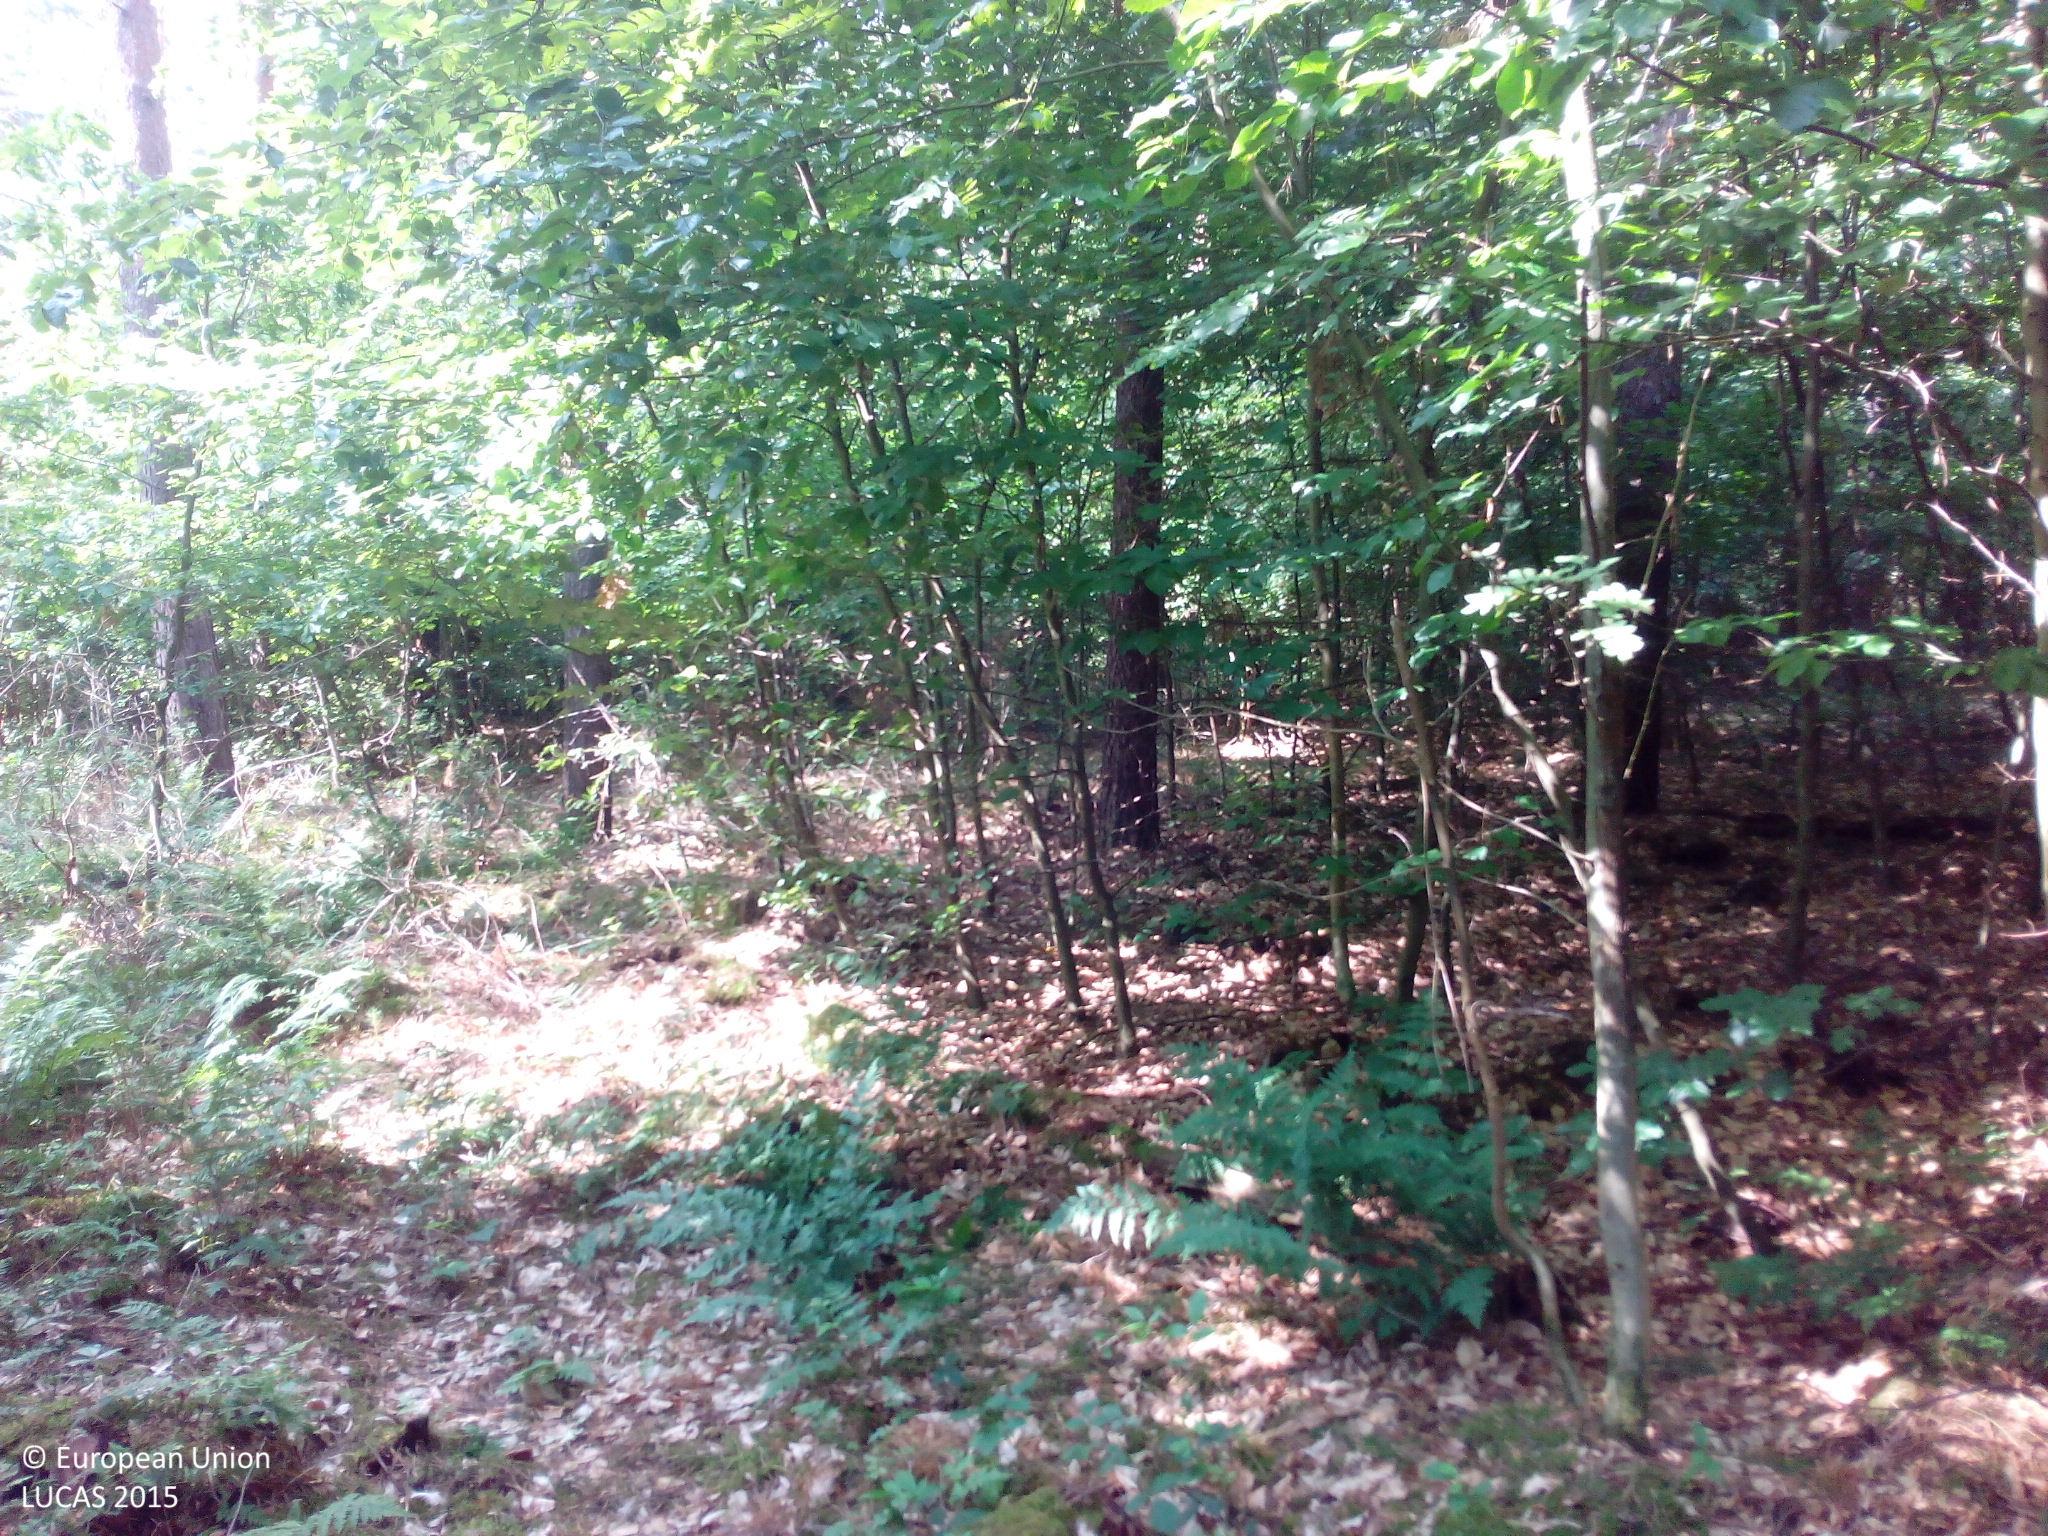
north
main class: Woodland
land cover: Pine dominated coniferous woodland
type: hemiboreal forest and nemoral coniferous forest and mixed broadleaved-coniferous forest
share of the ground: 50 - 75 %
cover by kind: coniferous forest trees 60 %, broadleaved forest trees 15 %, shrubs 10 %, herbaceous plants 10 %, lichens and mosses 5 %
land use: Forestry
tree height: > 5 m
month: July
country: DE
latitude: 52.6755
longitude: 12.4695
